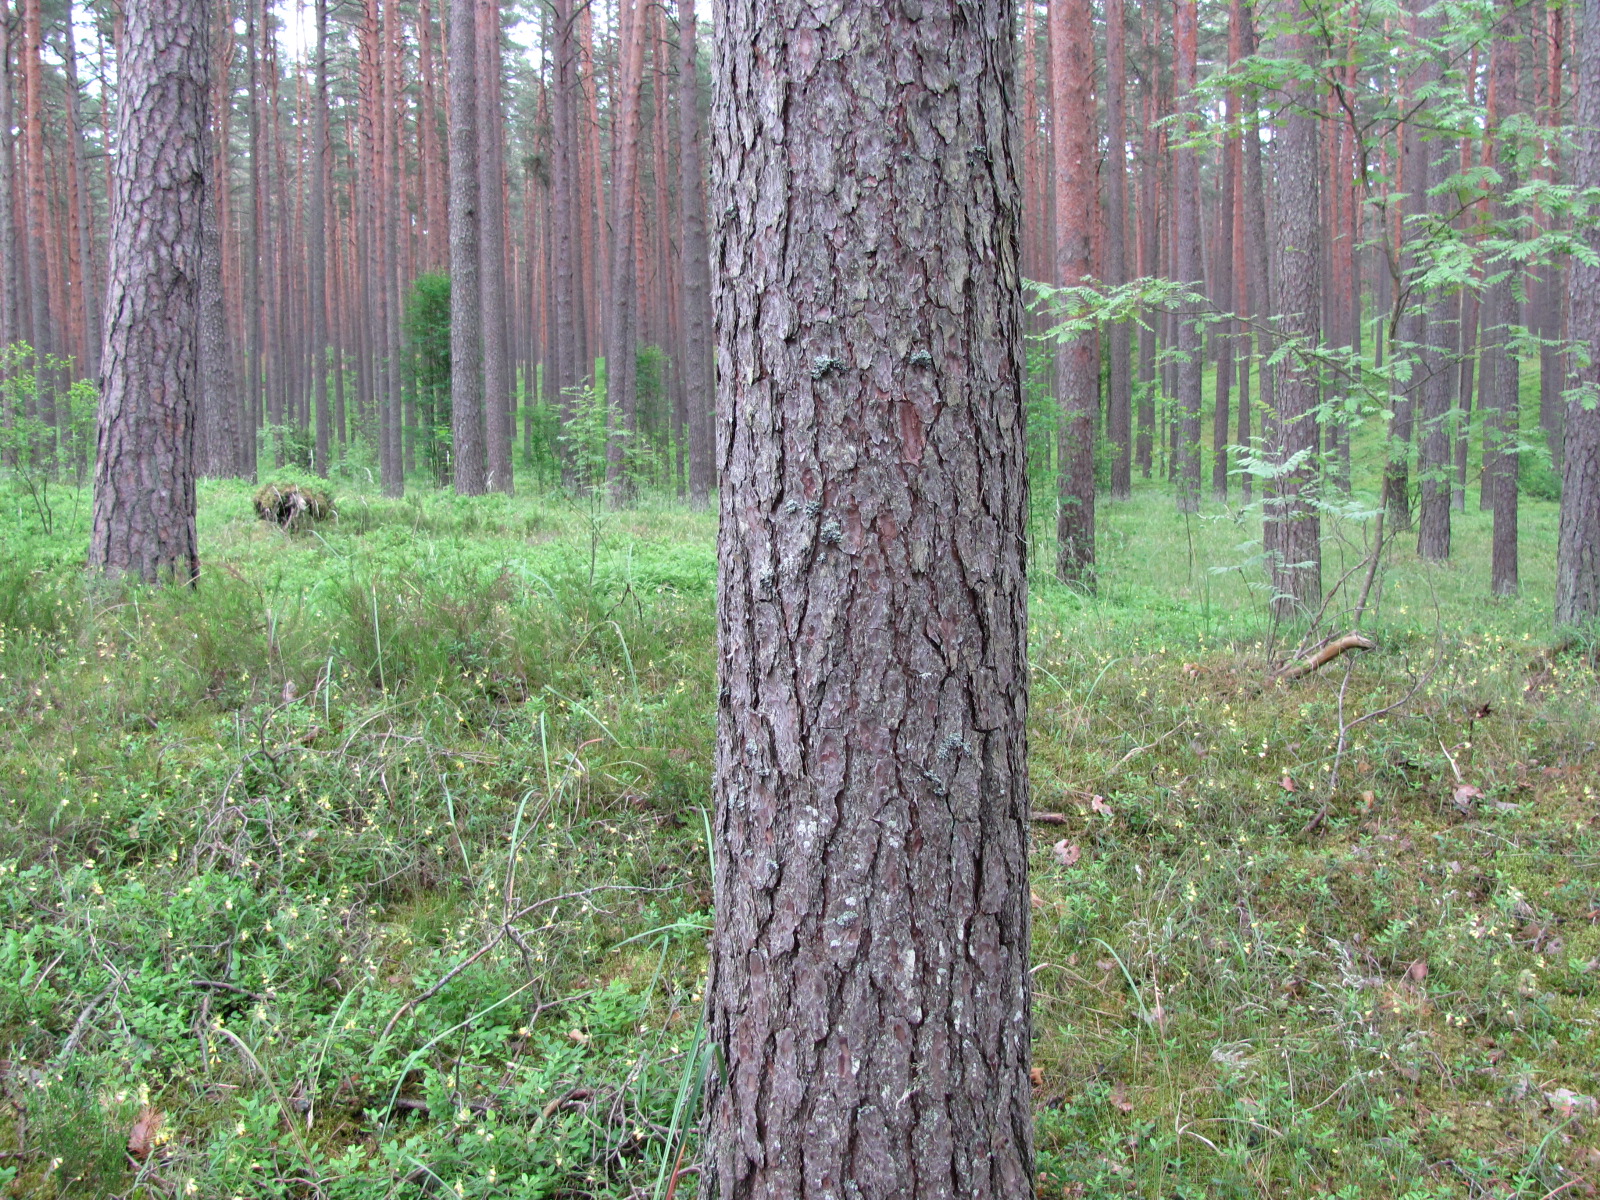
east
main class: Woodland
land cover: Pine dominated coniferous woodland
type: hemiboreal forest and nemoral coniferous forest and mixed broadleaved-coniferous forest
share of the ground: > 75 %
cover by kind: coniferous forest trees 80 %, herbaceous plants 10 %, lichens and mosses 10 %
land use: Forestry
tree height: > 5 m
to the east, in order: Pine dominated coniferous woodland; Tracks; Pine dominated coniferous woodland
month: June
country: LV
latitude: 56.9219
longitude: 23.9308
